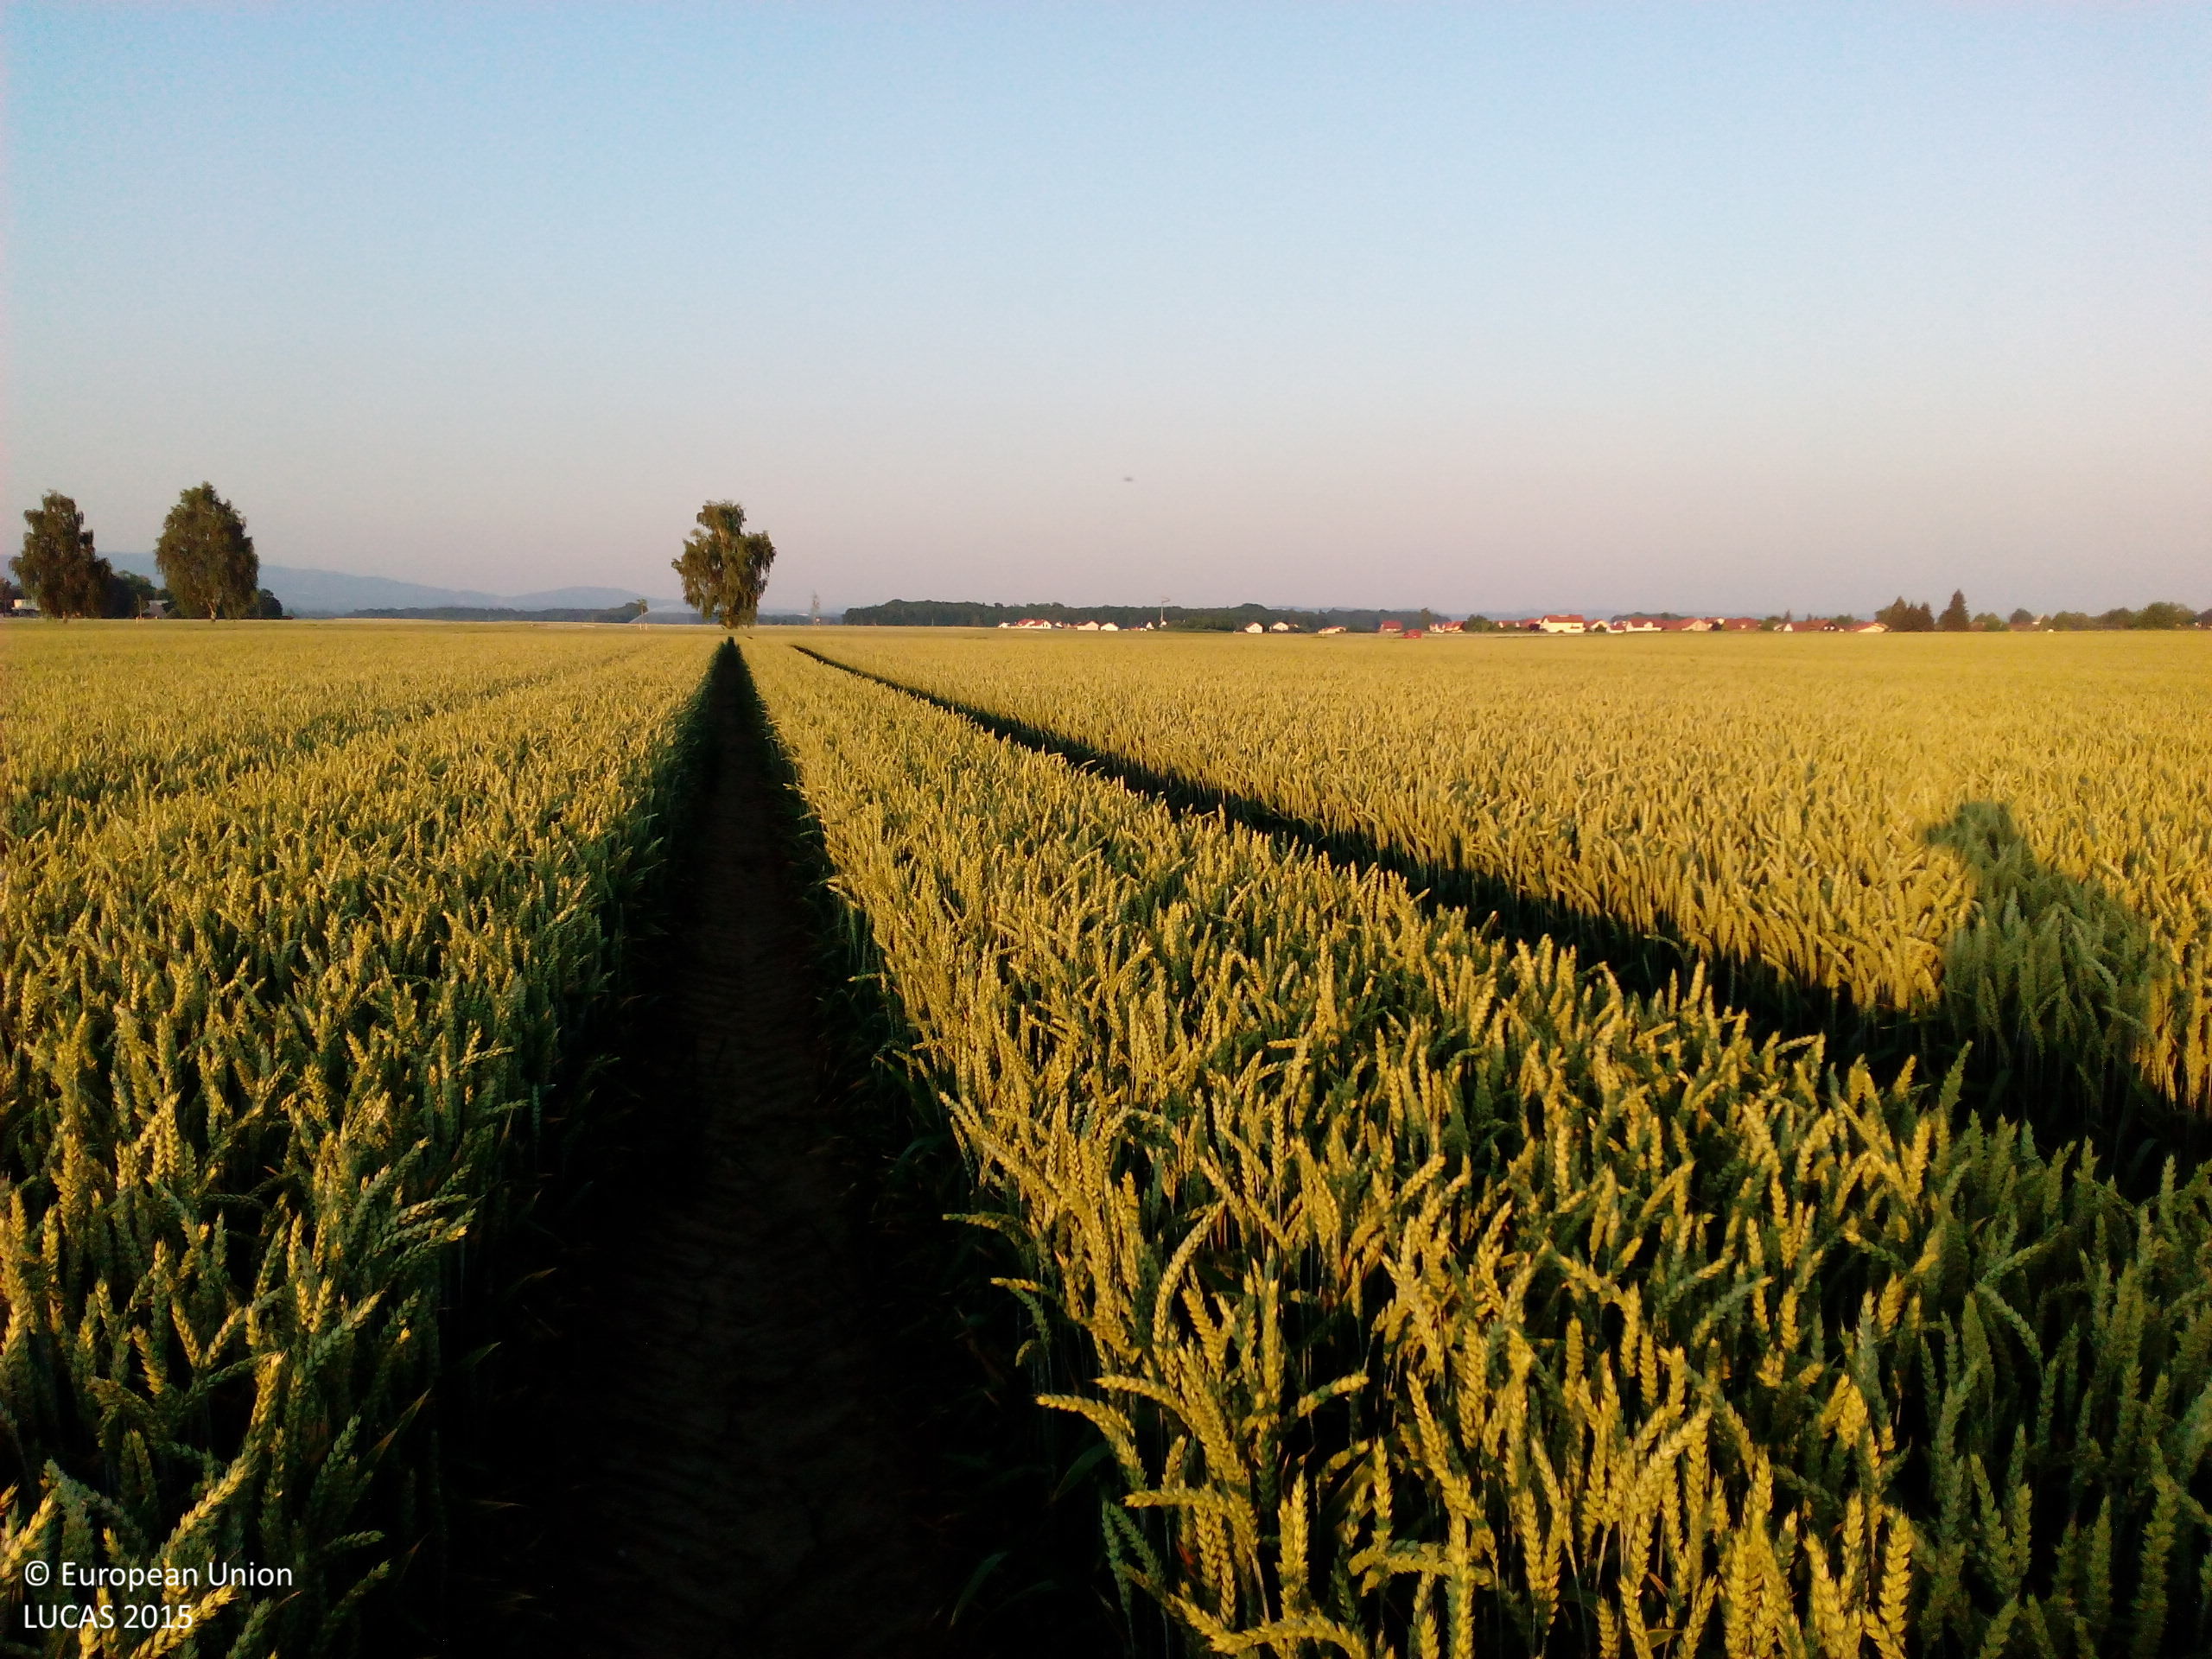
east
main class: Cropland
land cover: Common wheat
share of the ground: > 75 %
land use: Agriculture (excluding fallow land and kitchen gardens)
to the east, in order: Common wheat; Paved roads, cycling and walking lanes; Grassland with sparse tree/shrub cover; Potatoes
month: July
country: DE
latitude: 48.7422
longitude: 12.9503
